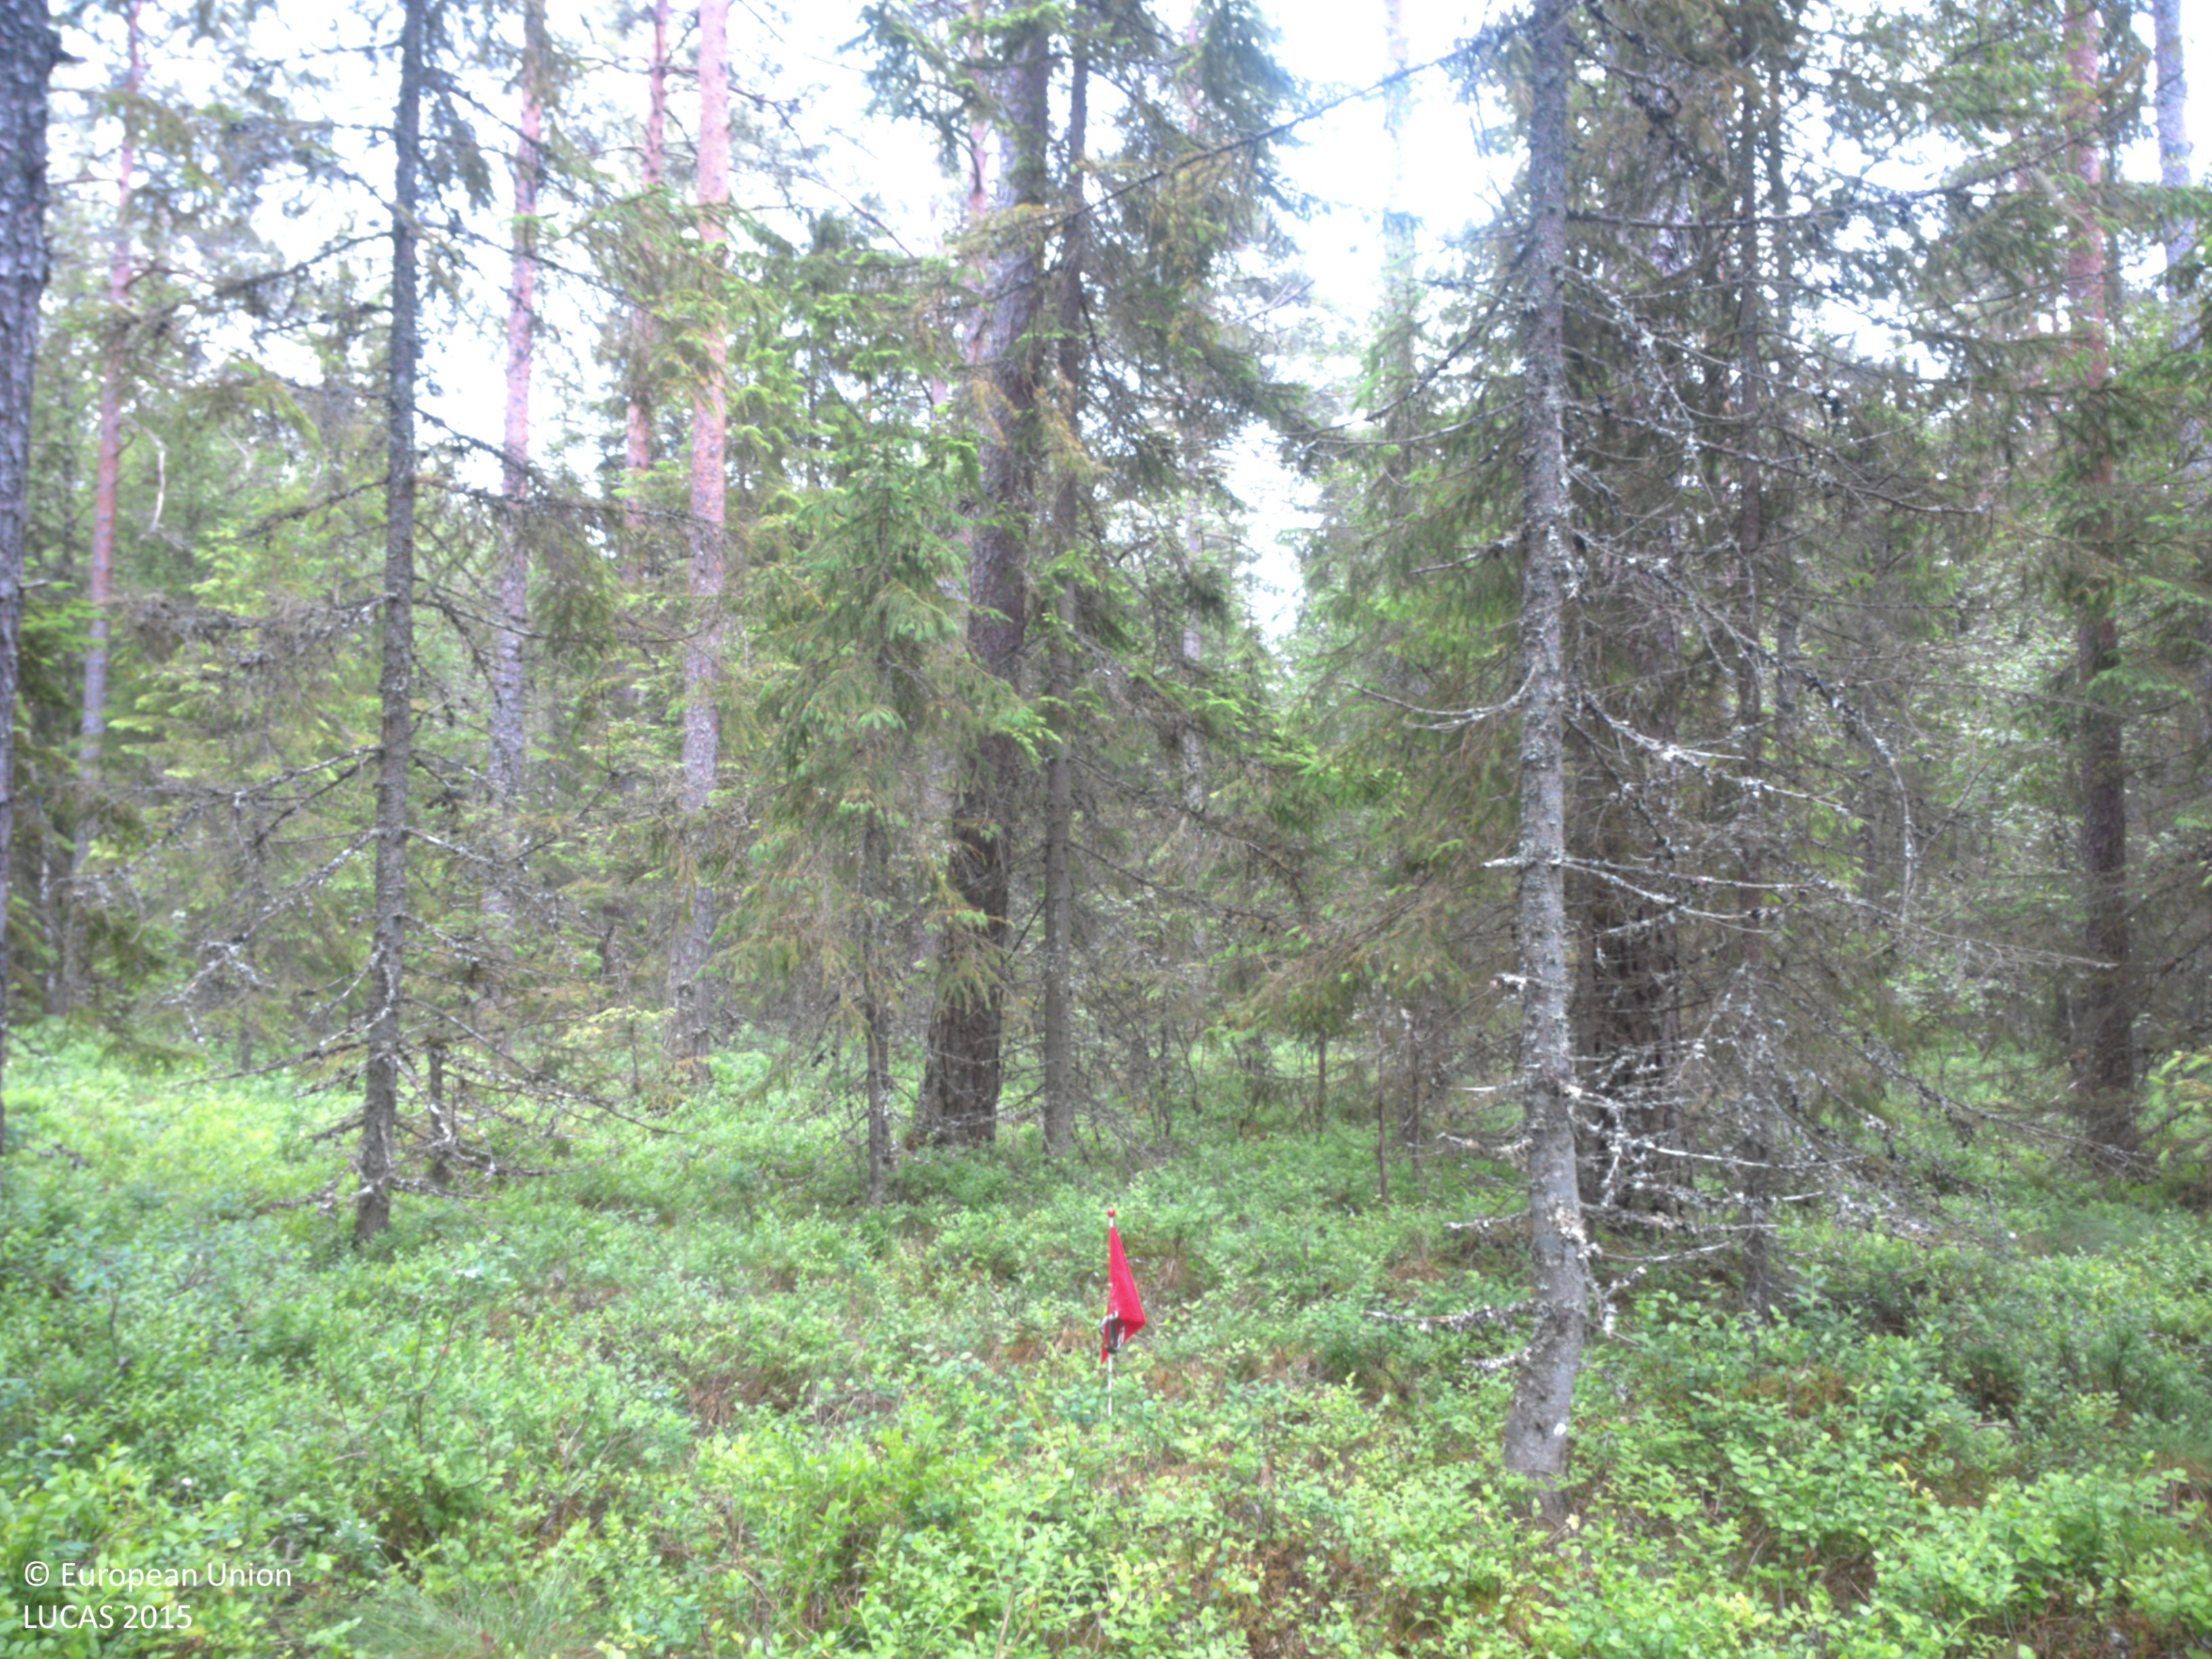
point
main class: Woodland
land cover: Spruce dominated coniferous woodland
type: boreal forest
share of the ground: 50 - 75 %
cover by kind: coniferous forest trees 50 %, lichens and mosses 40 %, herbaceous plants 10 %
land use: Forestry
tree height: > 5 m
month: June
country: SE
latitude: 58.9419
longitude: 12.0286
